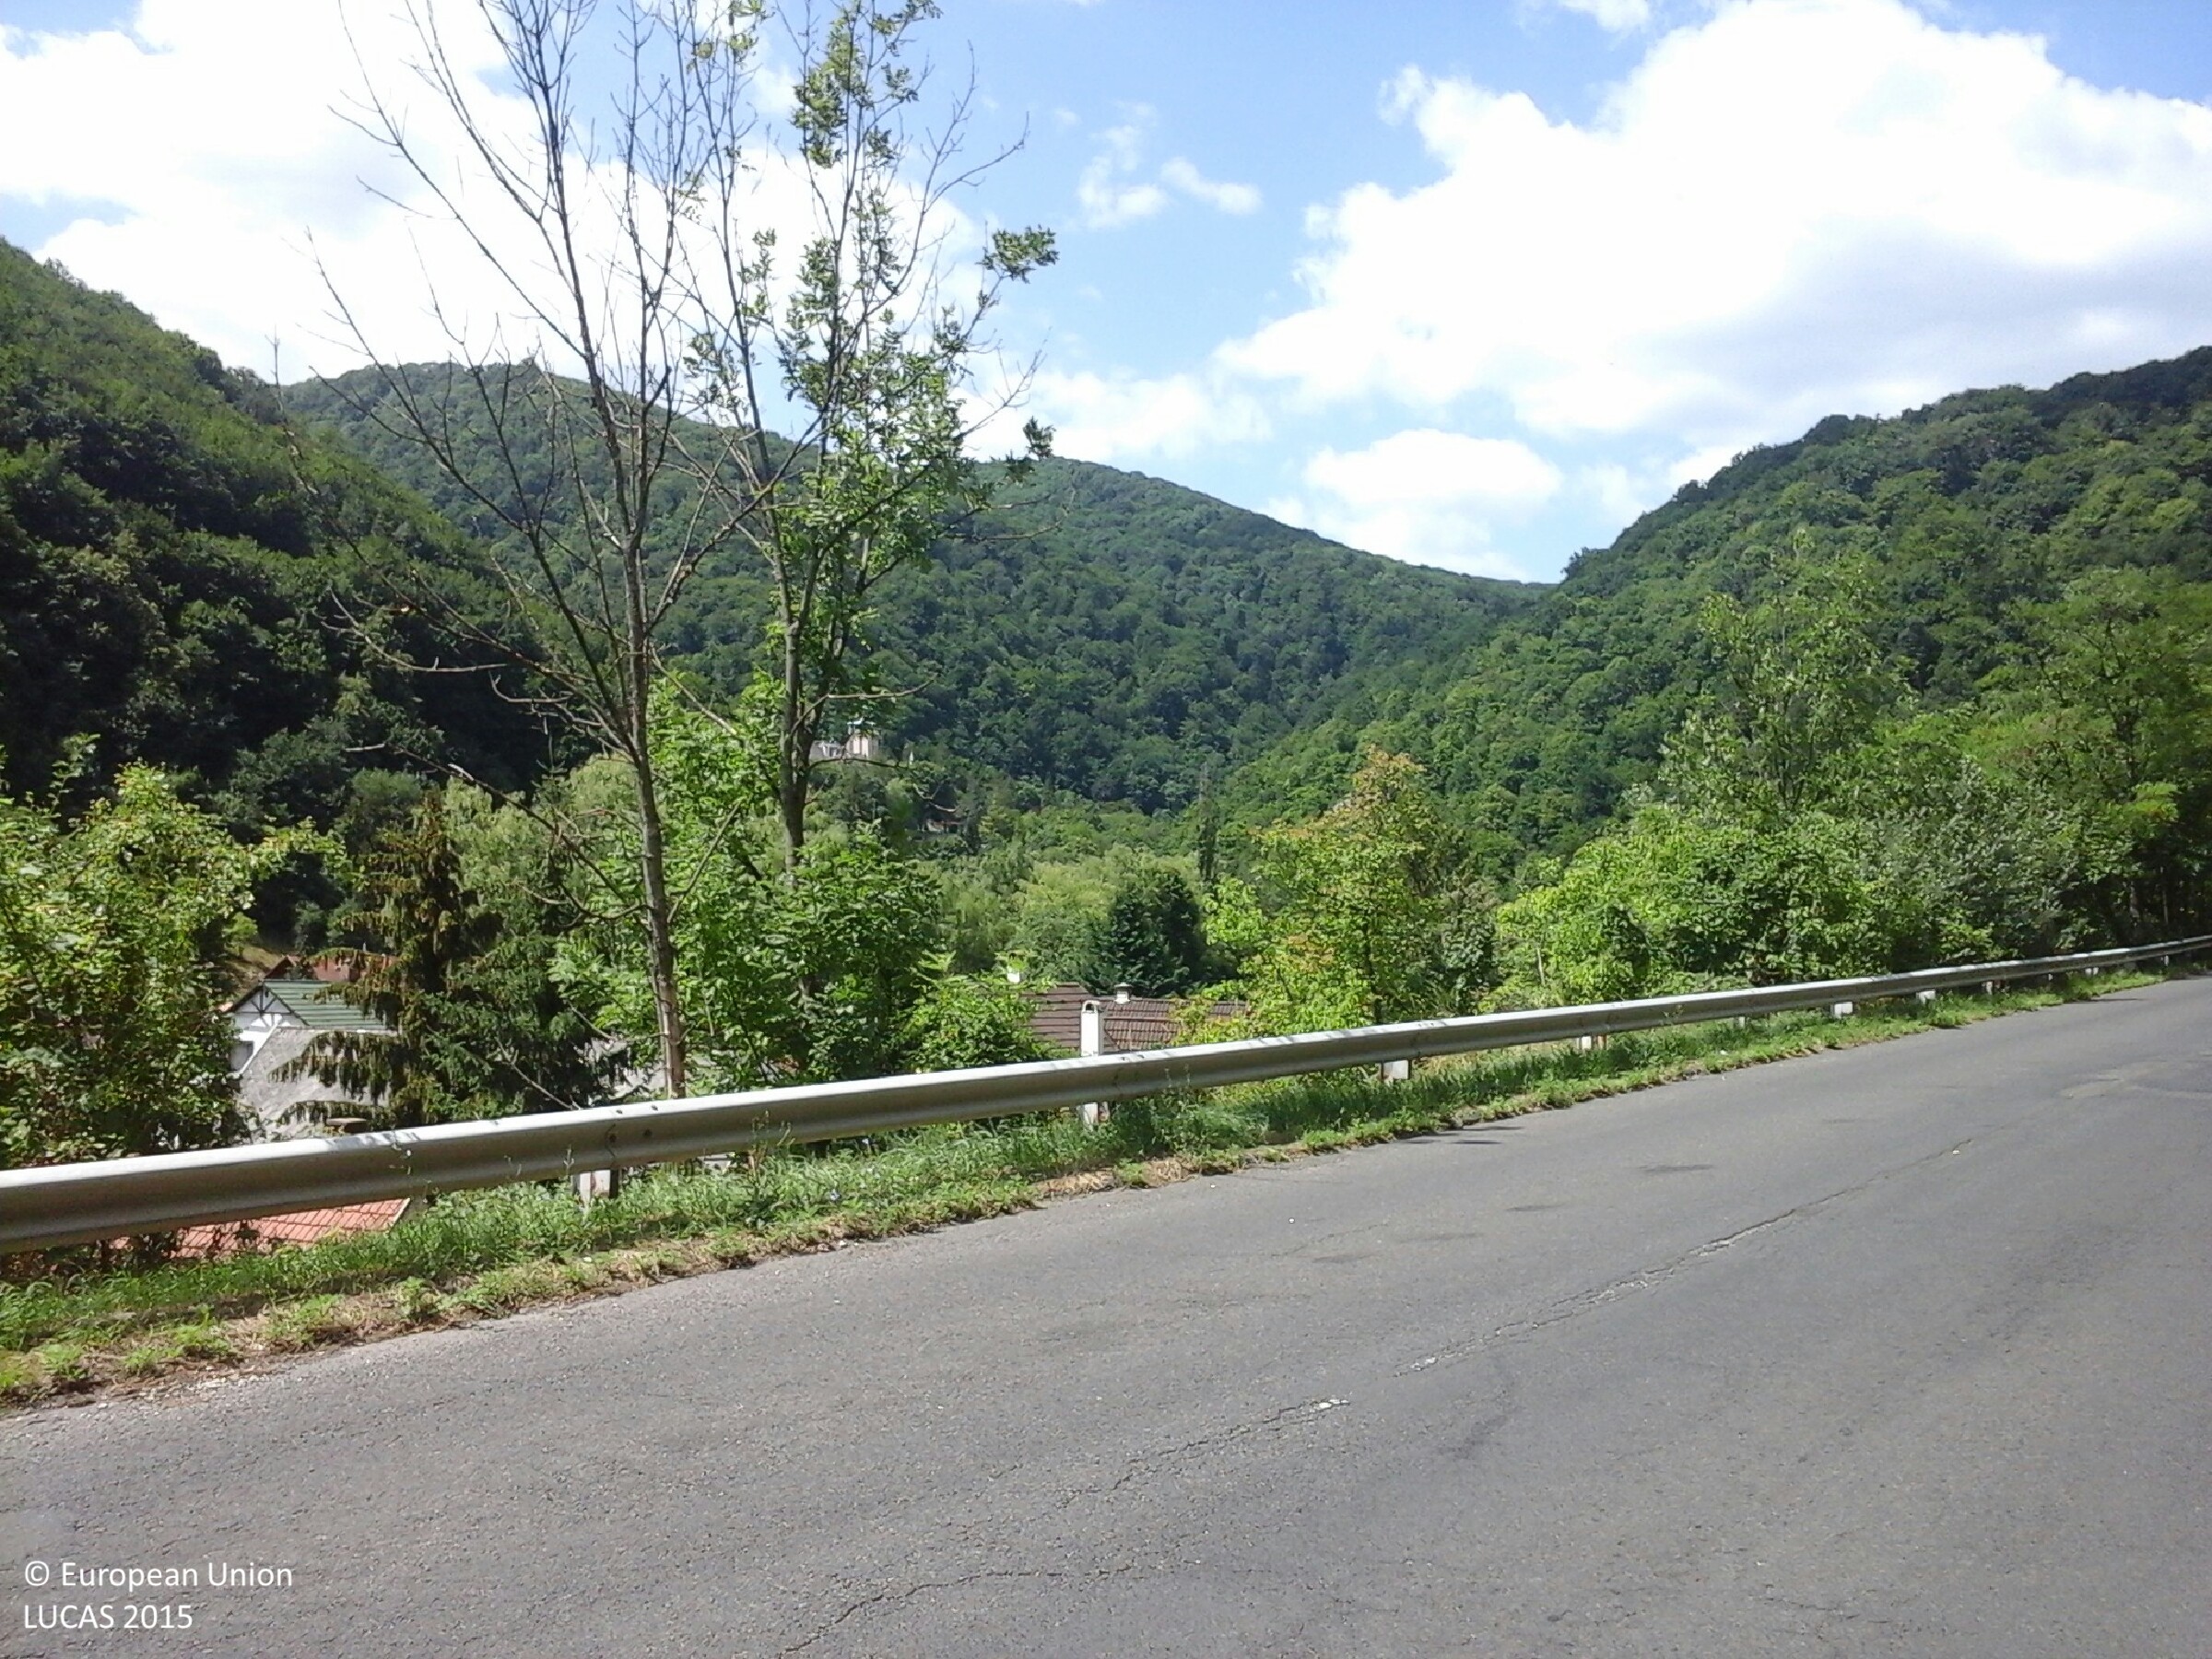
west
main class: Woodland
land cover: Broadleaved woodland
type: mesophytic deciduous forest
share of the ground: > 75 %
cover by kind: broadleaved forest trees 75 %, shrubs 20 %, herbaceous plants 5 %
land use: Forestry
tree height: > 5 m
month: July
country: HU
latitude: 48.1072
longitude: 20.6315
